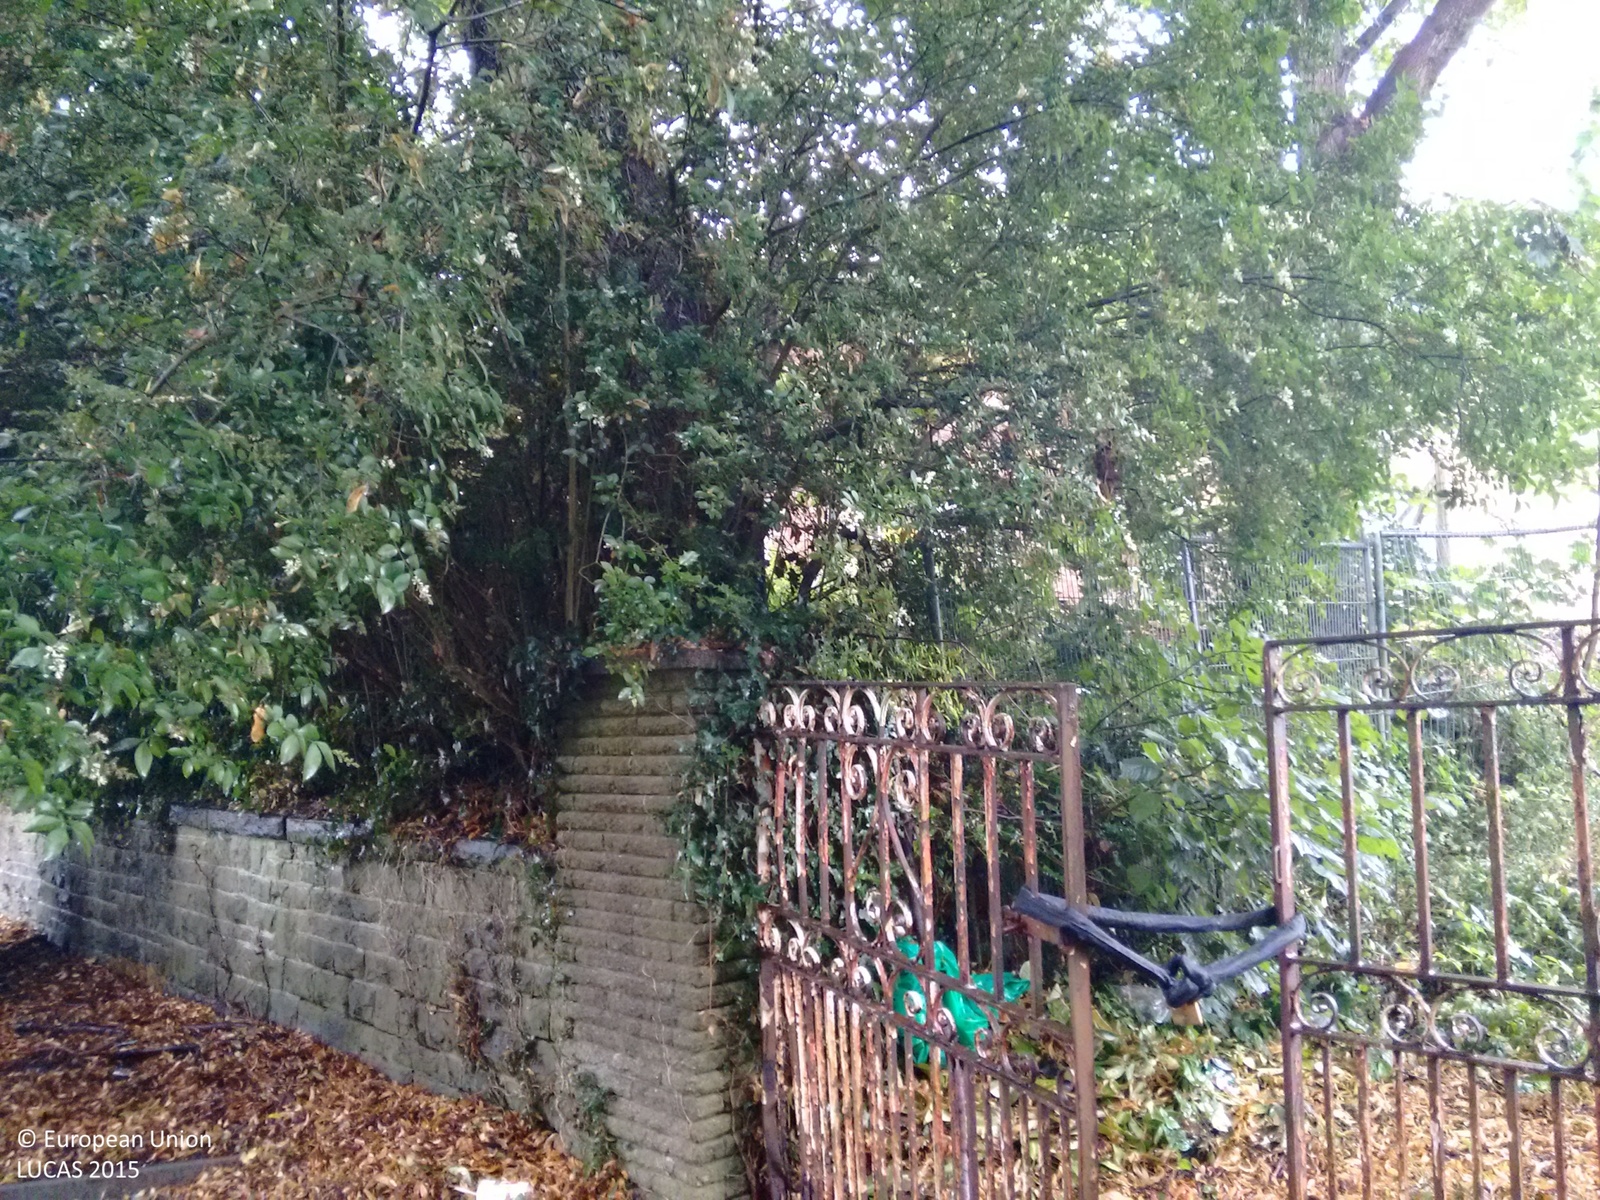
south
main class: Grassland
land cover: Grassland without tree/shrub cover
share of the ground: > 75 %
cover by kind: herbaceous plants 100 %
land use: Residential
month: July
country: GB
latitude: 51.6008
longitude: -3.3496
